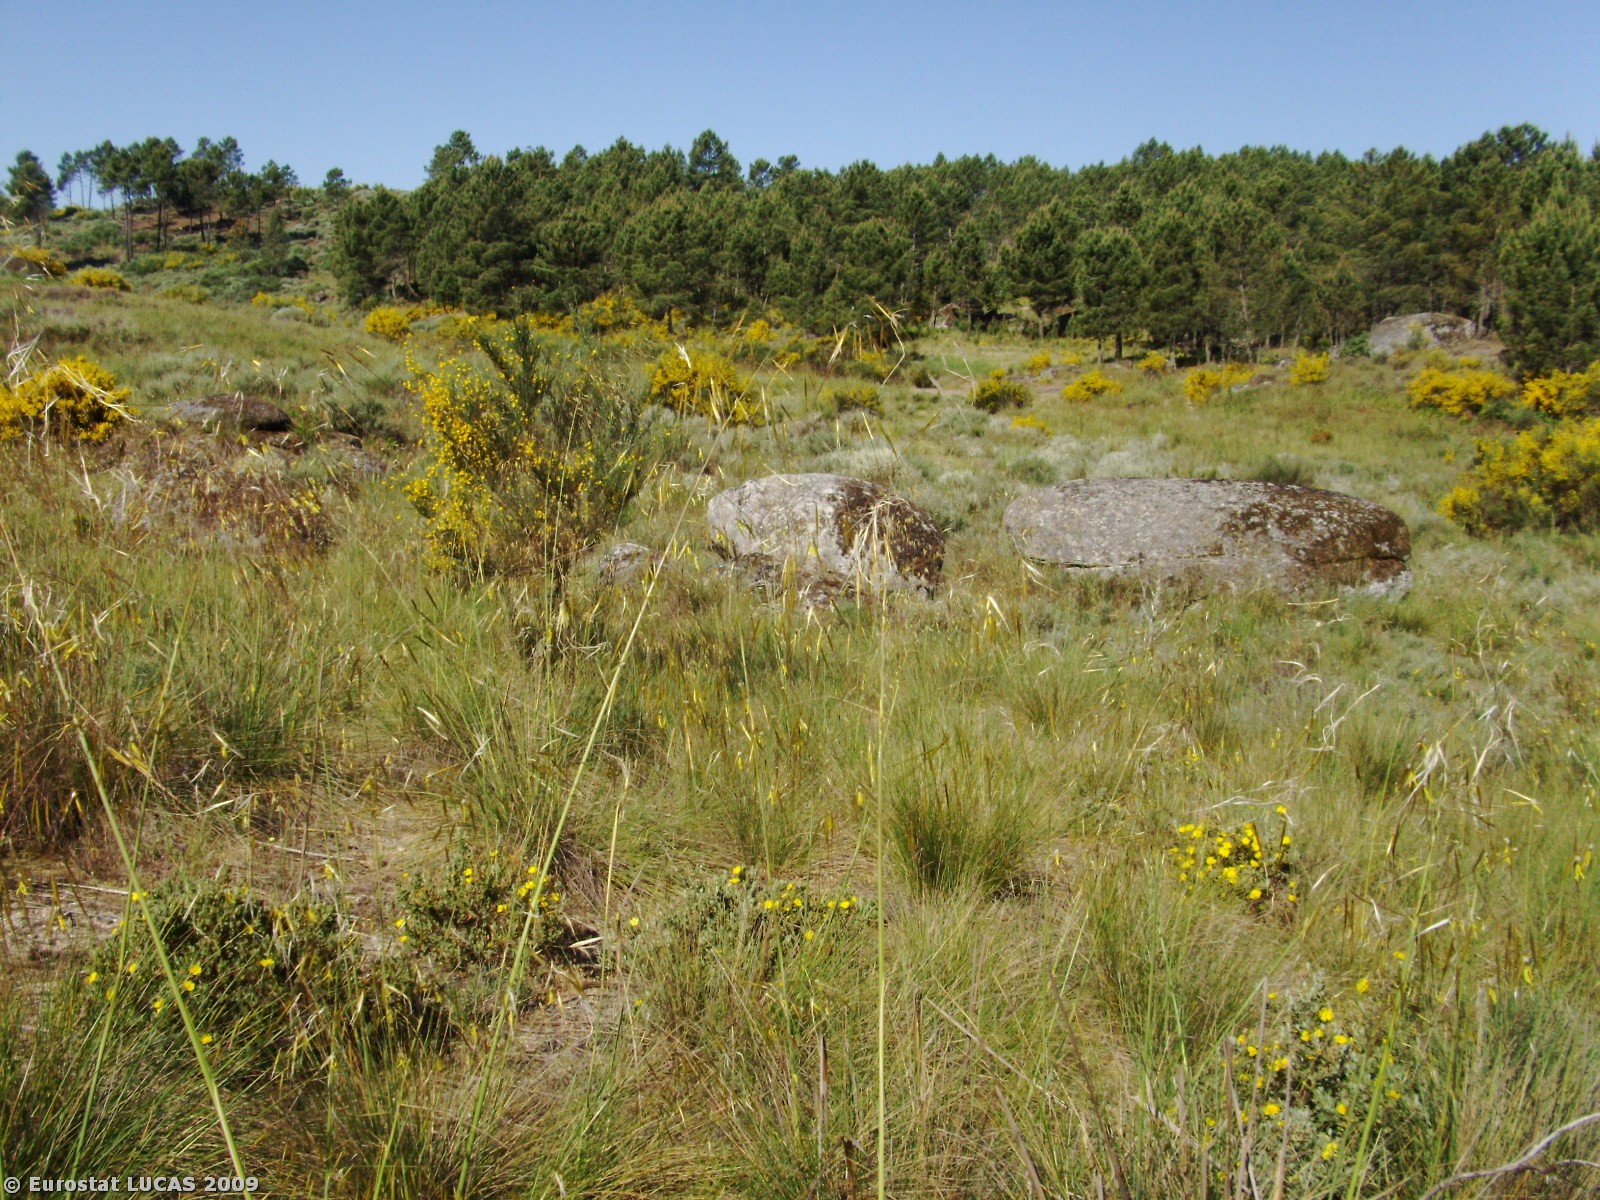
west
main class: Shrubland
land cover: Shrubland with sparse tree cover
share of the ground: > 75 %
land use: Unused
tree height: > 5 m
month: May
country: PT
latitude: 40.7660
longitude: -7.3971
